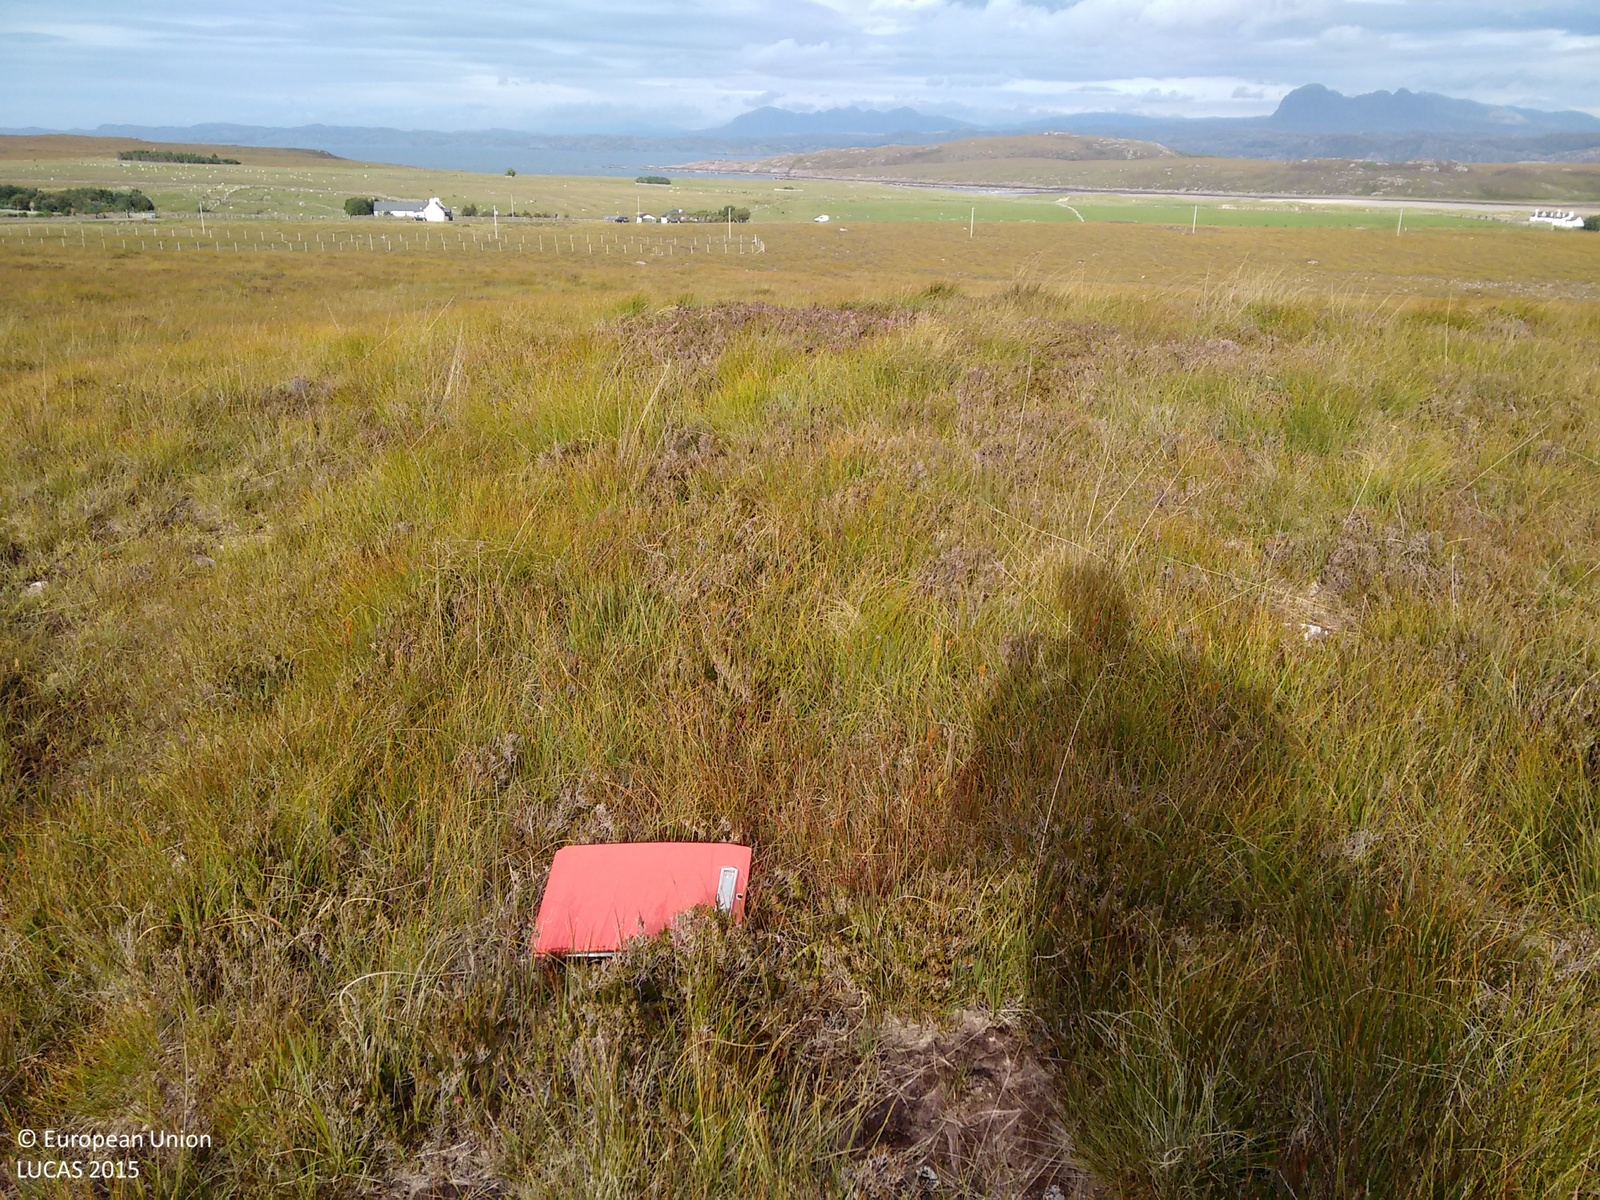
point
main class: Shrubland
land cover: Shrubland without tree cover
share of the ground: > 75 %
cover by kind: shrubs 75 %, herbaceous plants 25 %
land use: Agriculture (excluding fallow land and kitchen gardens)
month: September
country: GB
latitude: 58.0611
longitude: -5.3789
